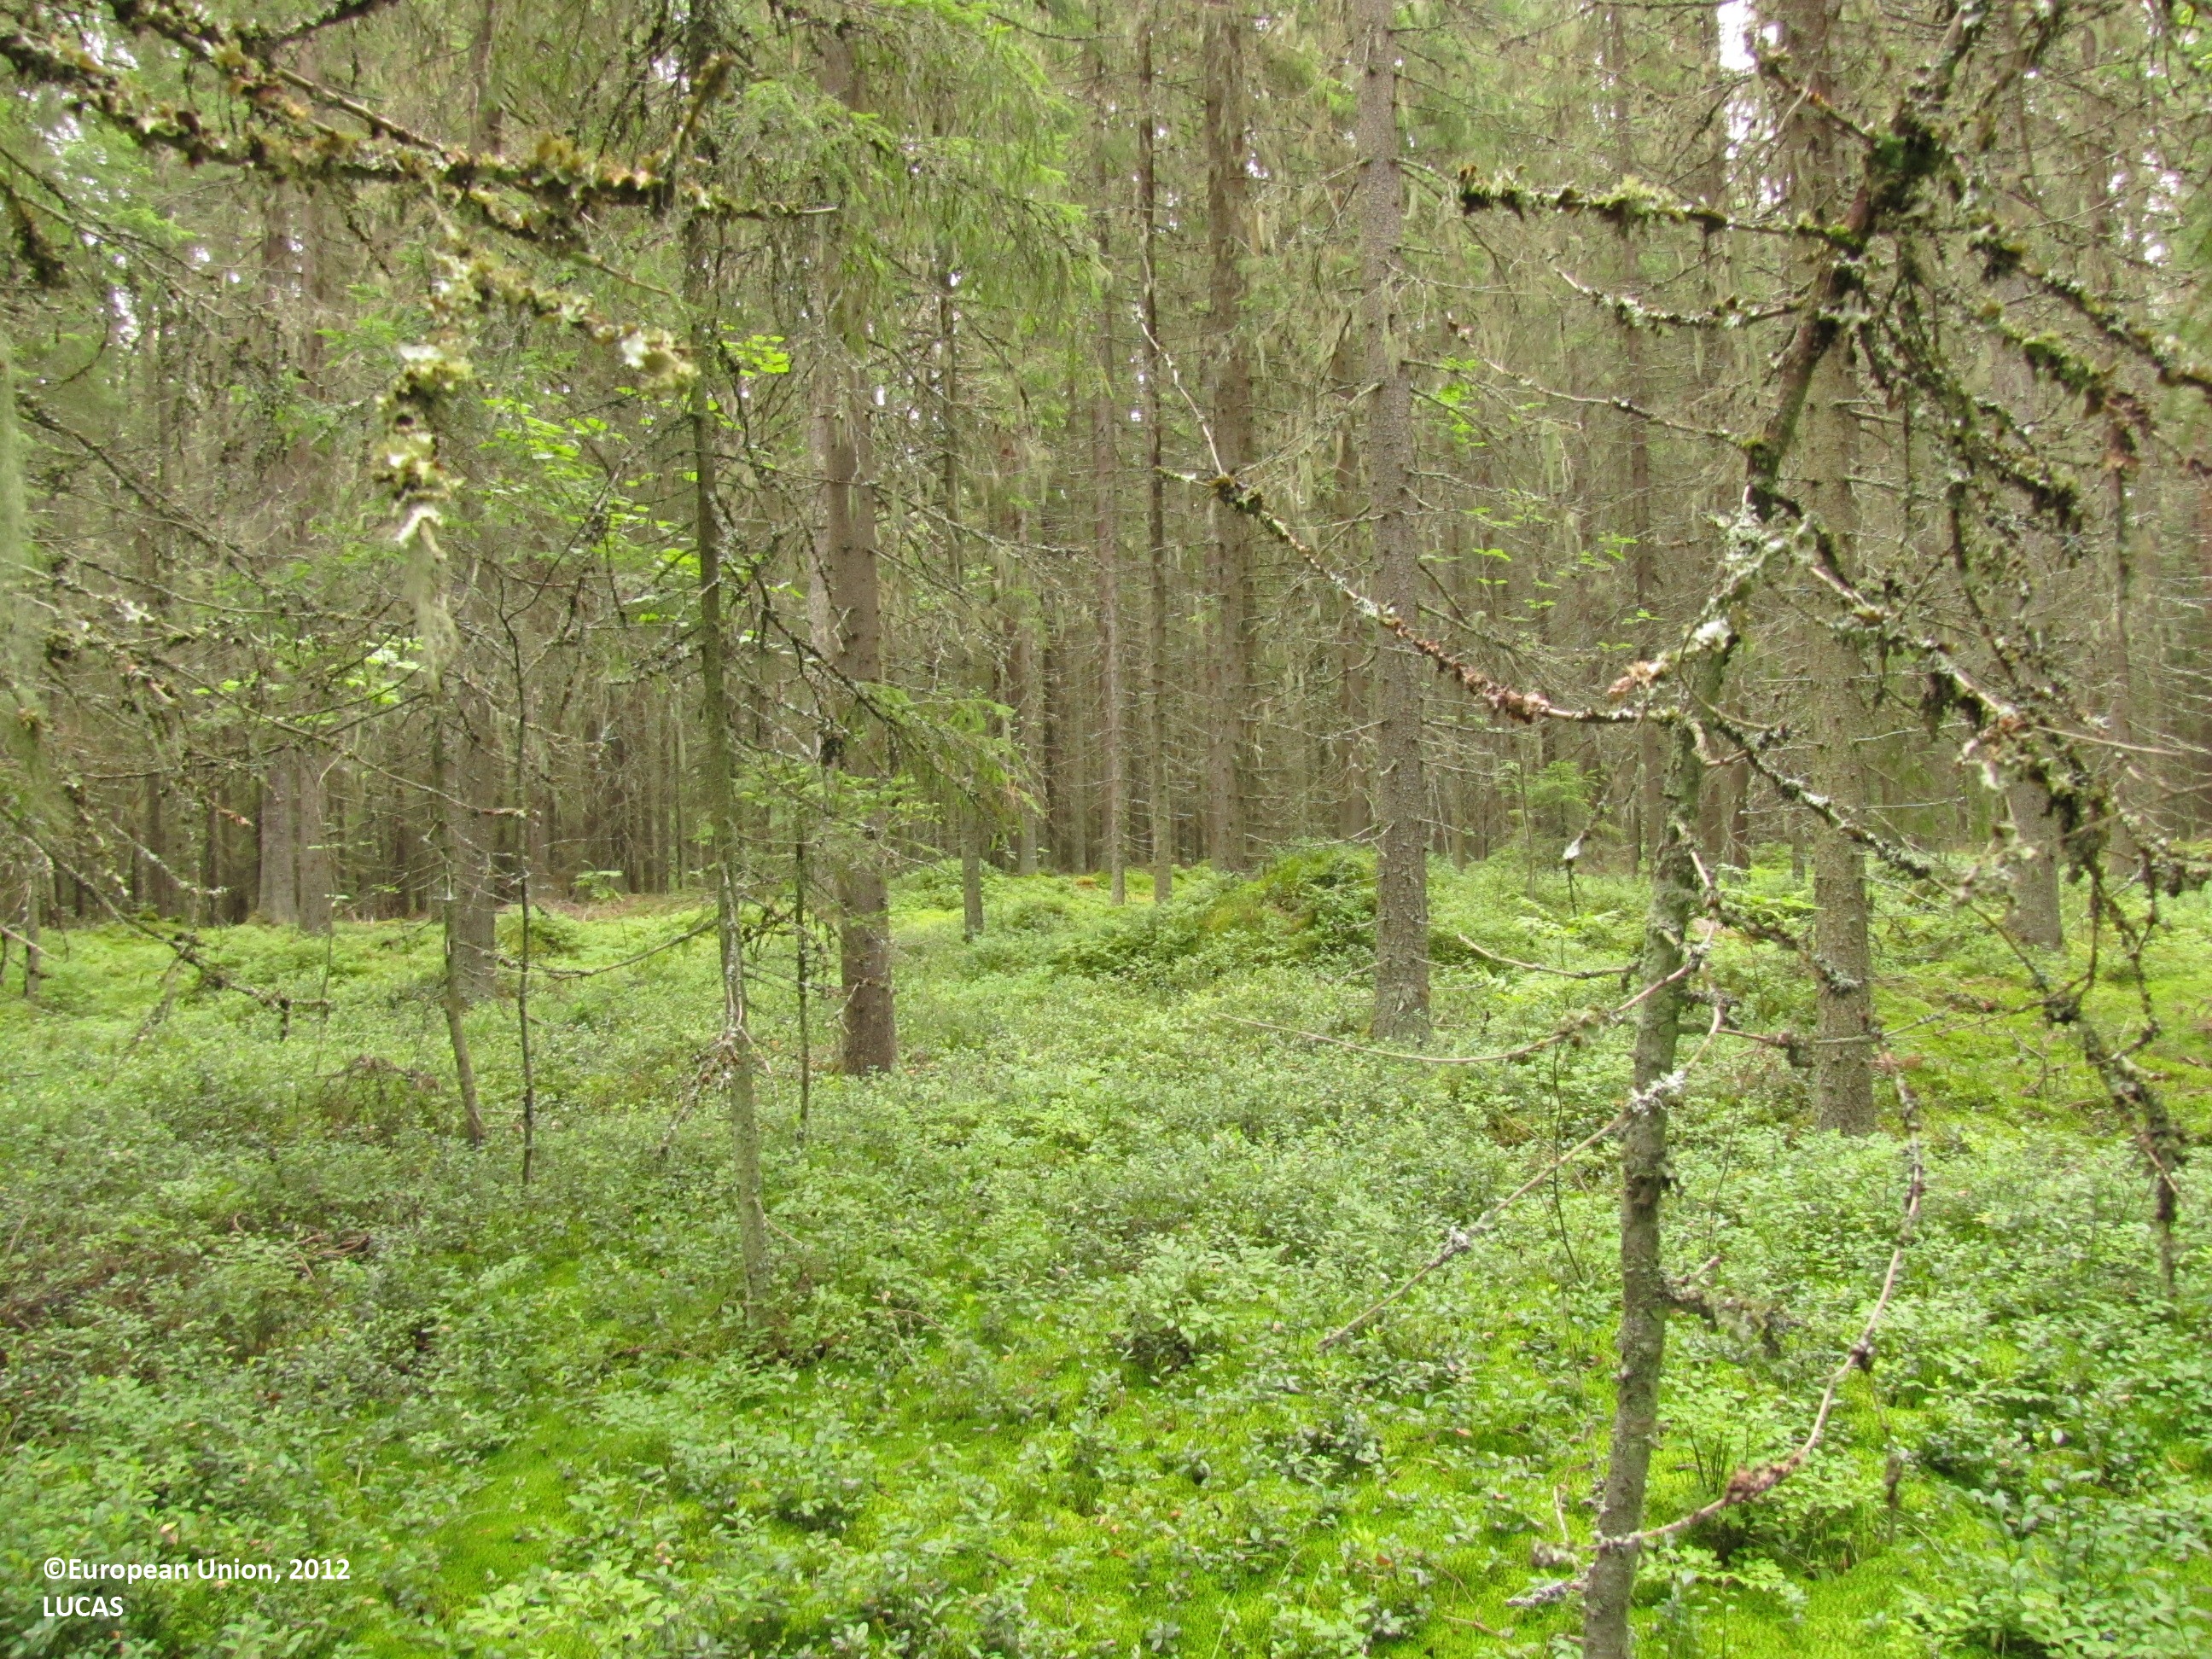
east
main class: Woodland
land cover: Spruce dominated coniferous woodland
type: boreal forest
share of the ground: > 75 %
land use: Forestry
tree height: > 5 m
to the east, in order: Spruce dominated coniferous woodland; Tracks; Spruce dominated coniferous woodland; Ditches and canals; Spruce dominated mixed woodland; Pine dominated coniferous woodland; Ditches and canals; Grassland with sparse tree/shrub cover; Ditches and canals; Abandoned hedges; Broadleaved woodland; Ditches and canals; Barley
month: August
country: FI
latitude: 61.8361
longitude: 22.8862
